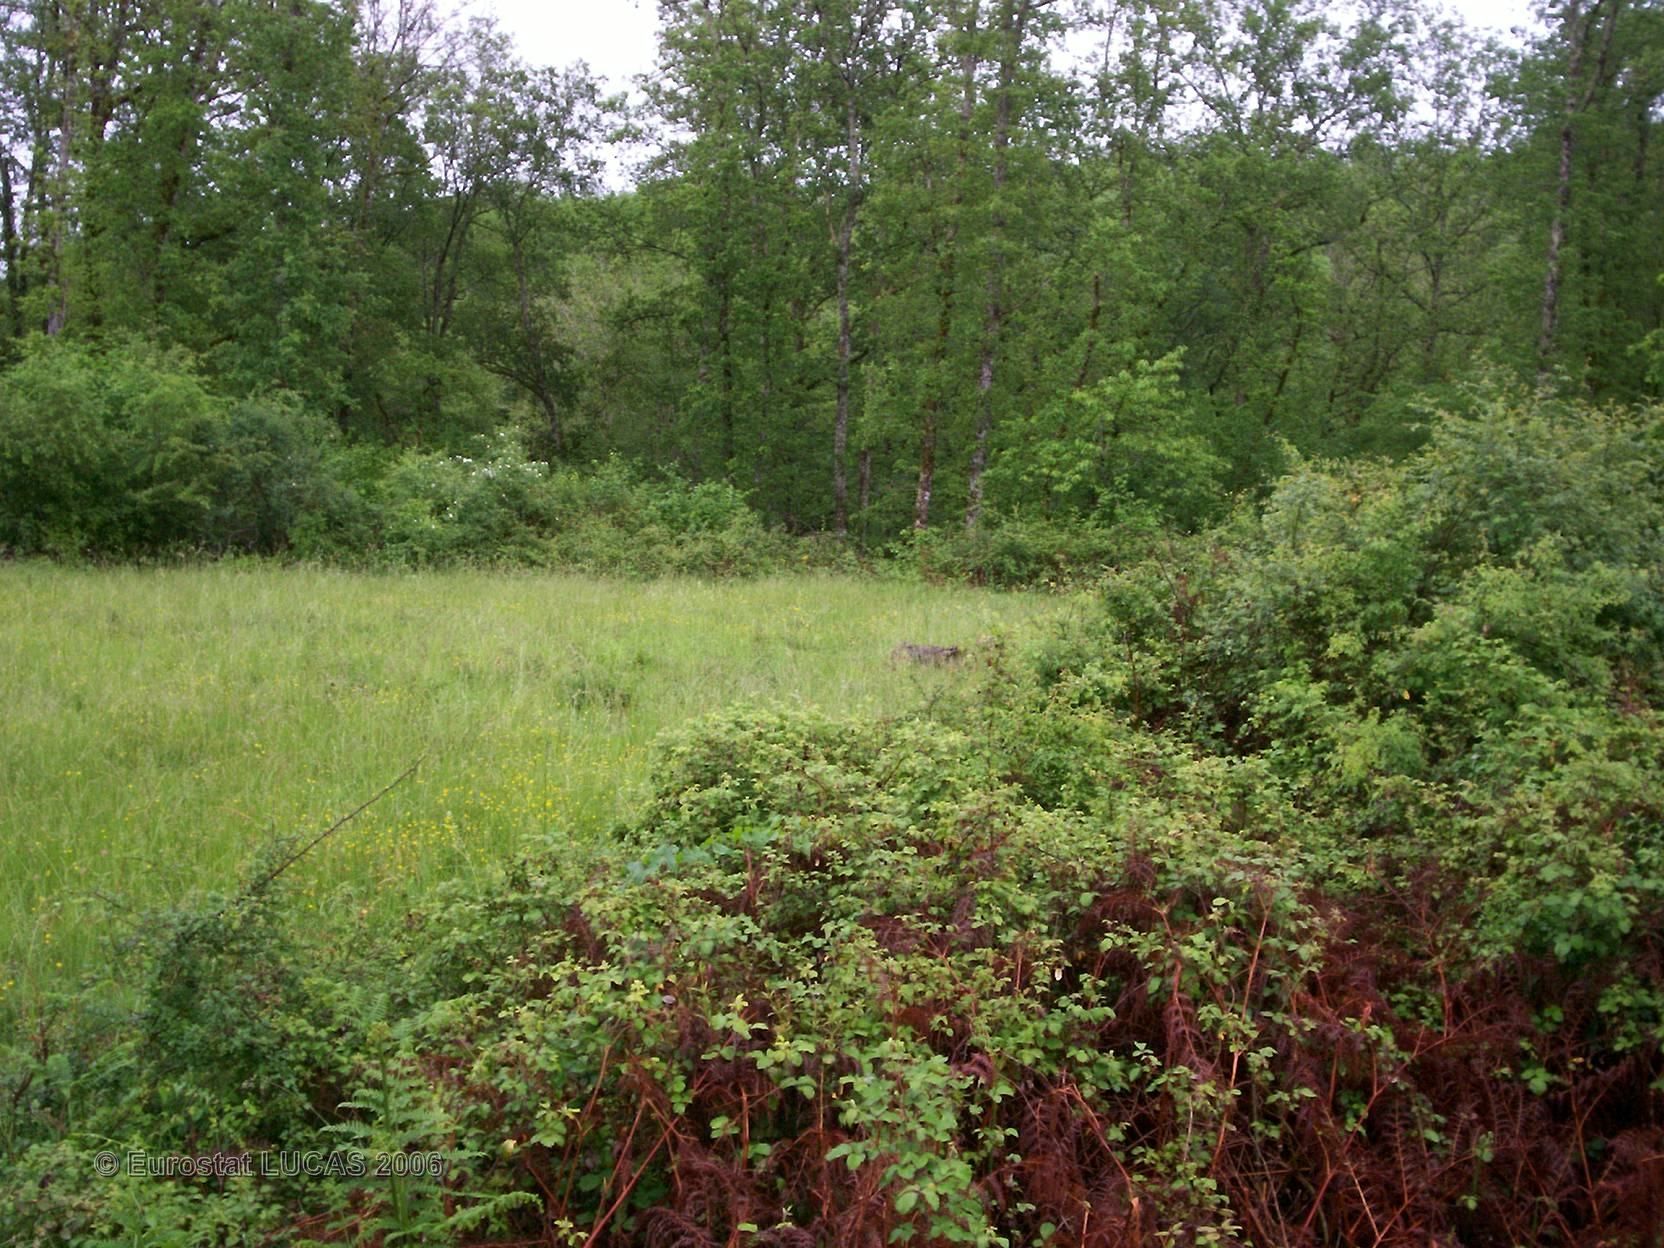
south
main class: Grassland
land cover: Grassland with sparse tree/shrub cover
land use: Agriculture (excluding fallow land and kitchen gardens)
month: May
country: FR
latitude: 45.4058
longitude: 0.5461
